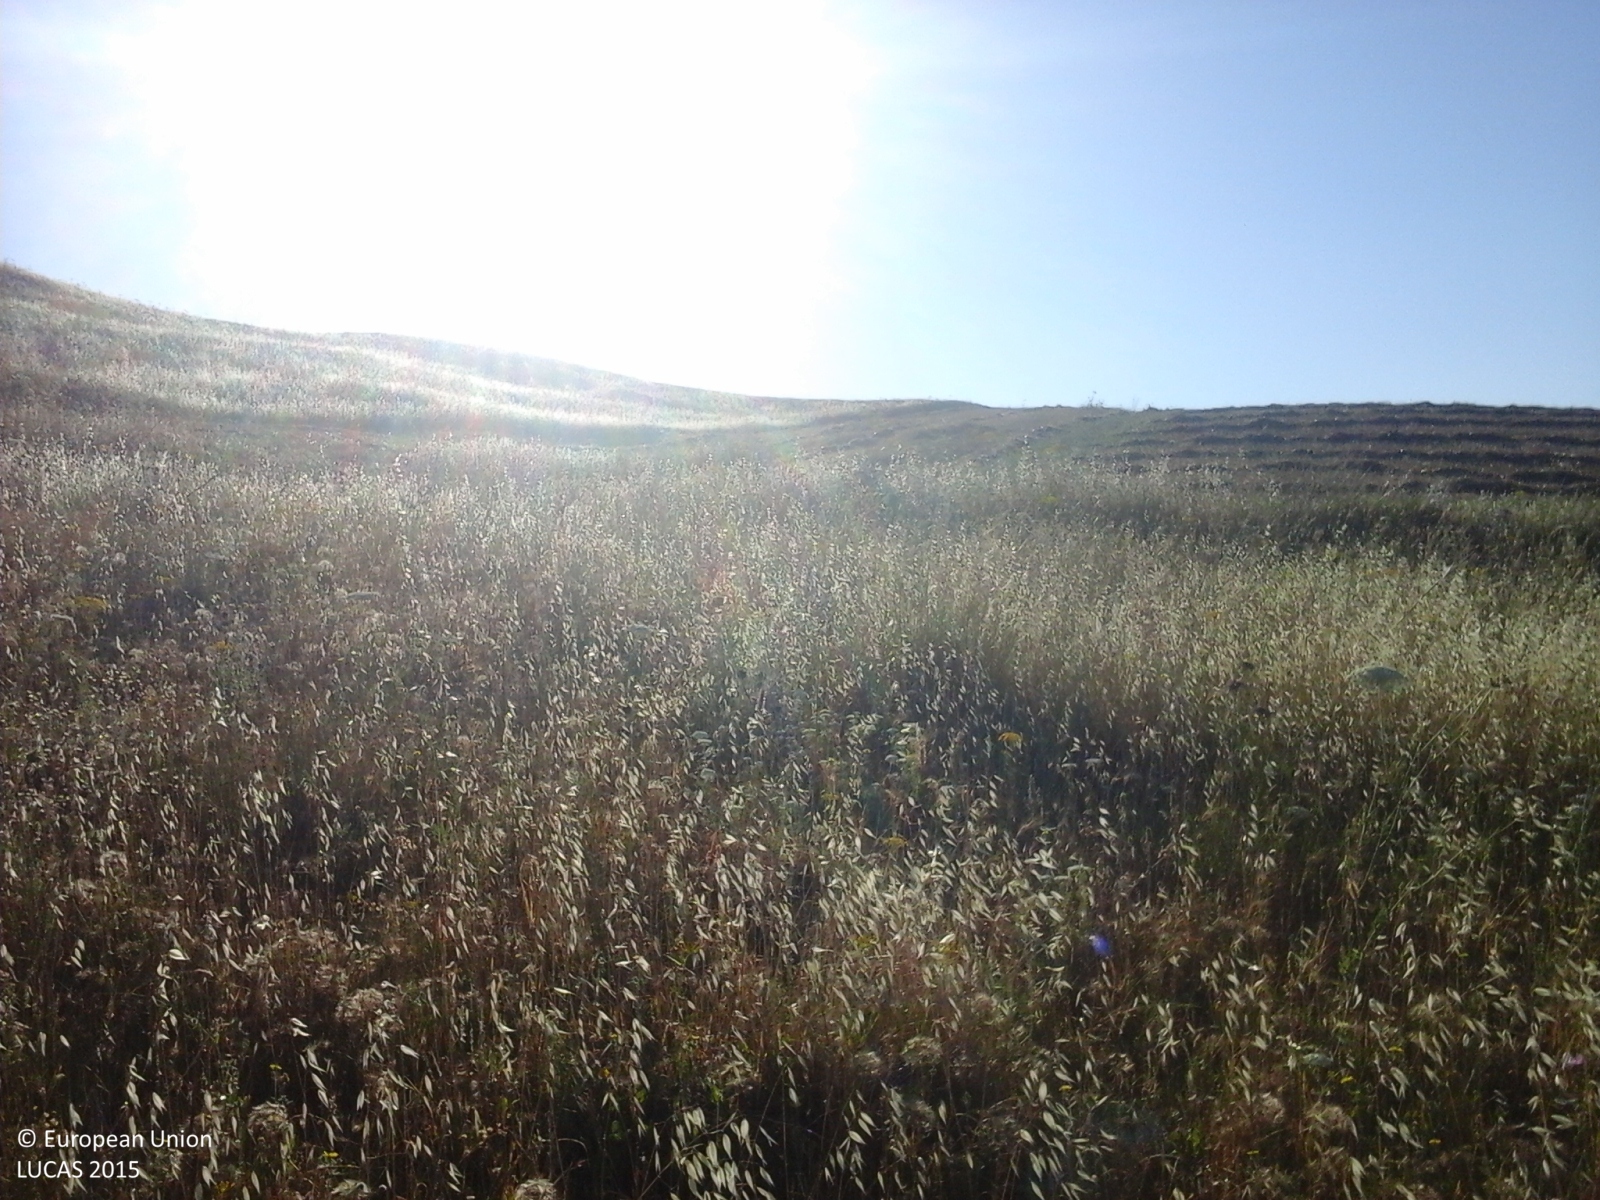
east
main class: Grassland
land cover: Grassland without tree/shrub cover
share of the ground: > 75 %
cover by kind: herbaceous plants 100 %
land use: Agriculture (excluding fallow land and kitchen gardens)
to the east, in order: Grassland without tree/shrub cover; Temporary grasslands; Grass margins; Temporary grasslands; Other leguminous and mixtures for fodder; Barley; Durum wheat
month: June
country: IT
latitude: 37.7666
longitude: 14.1365
